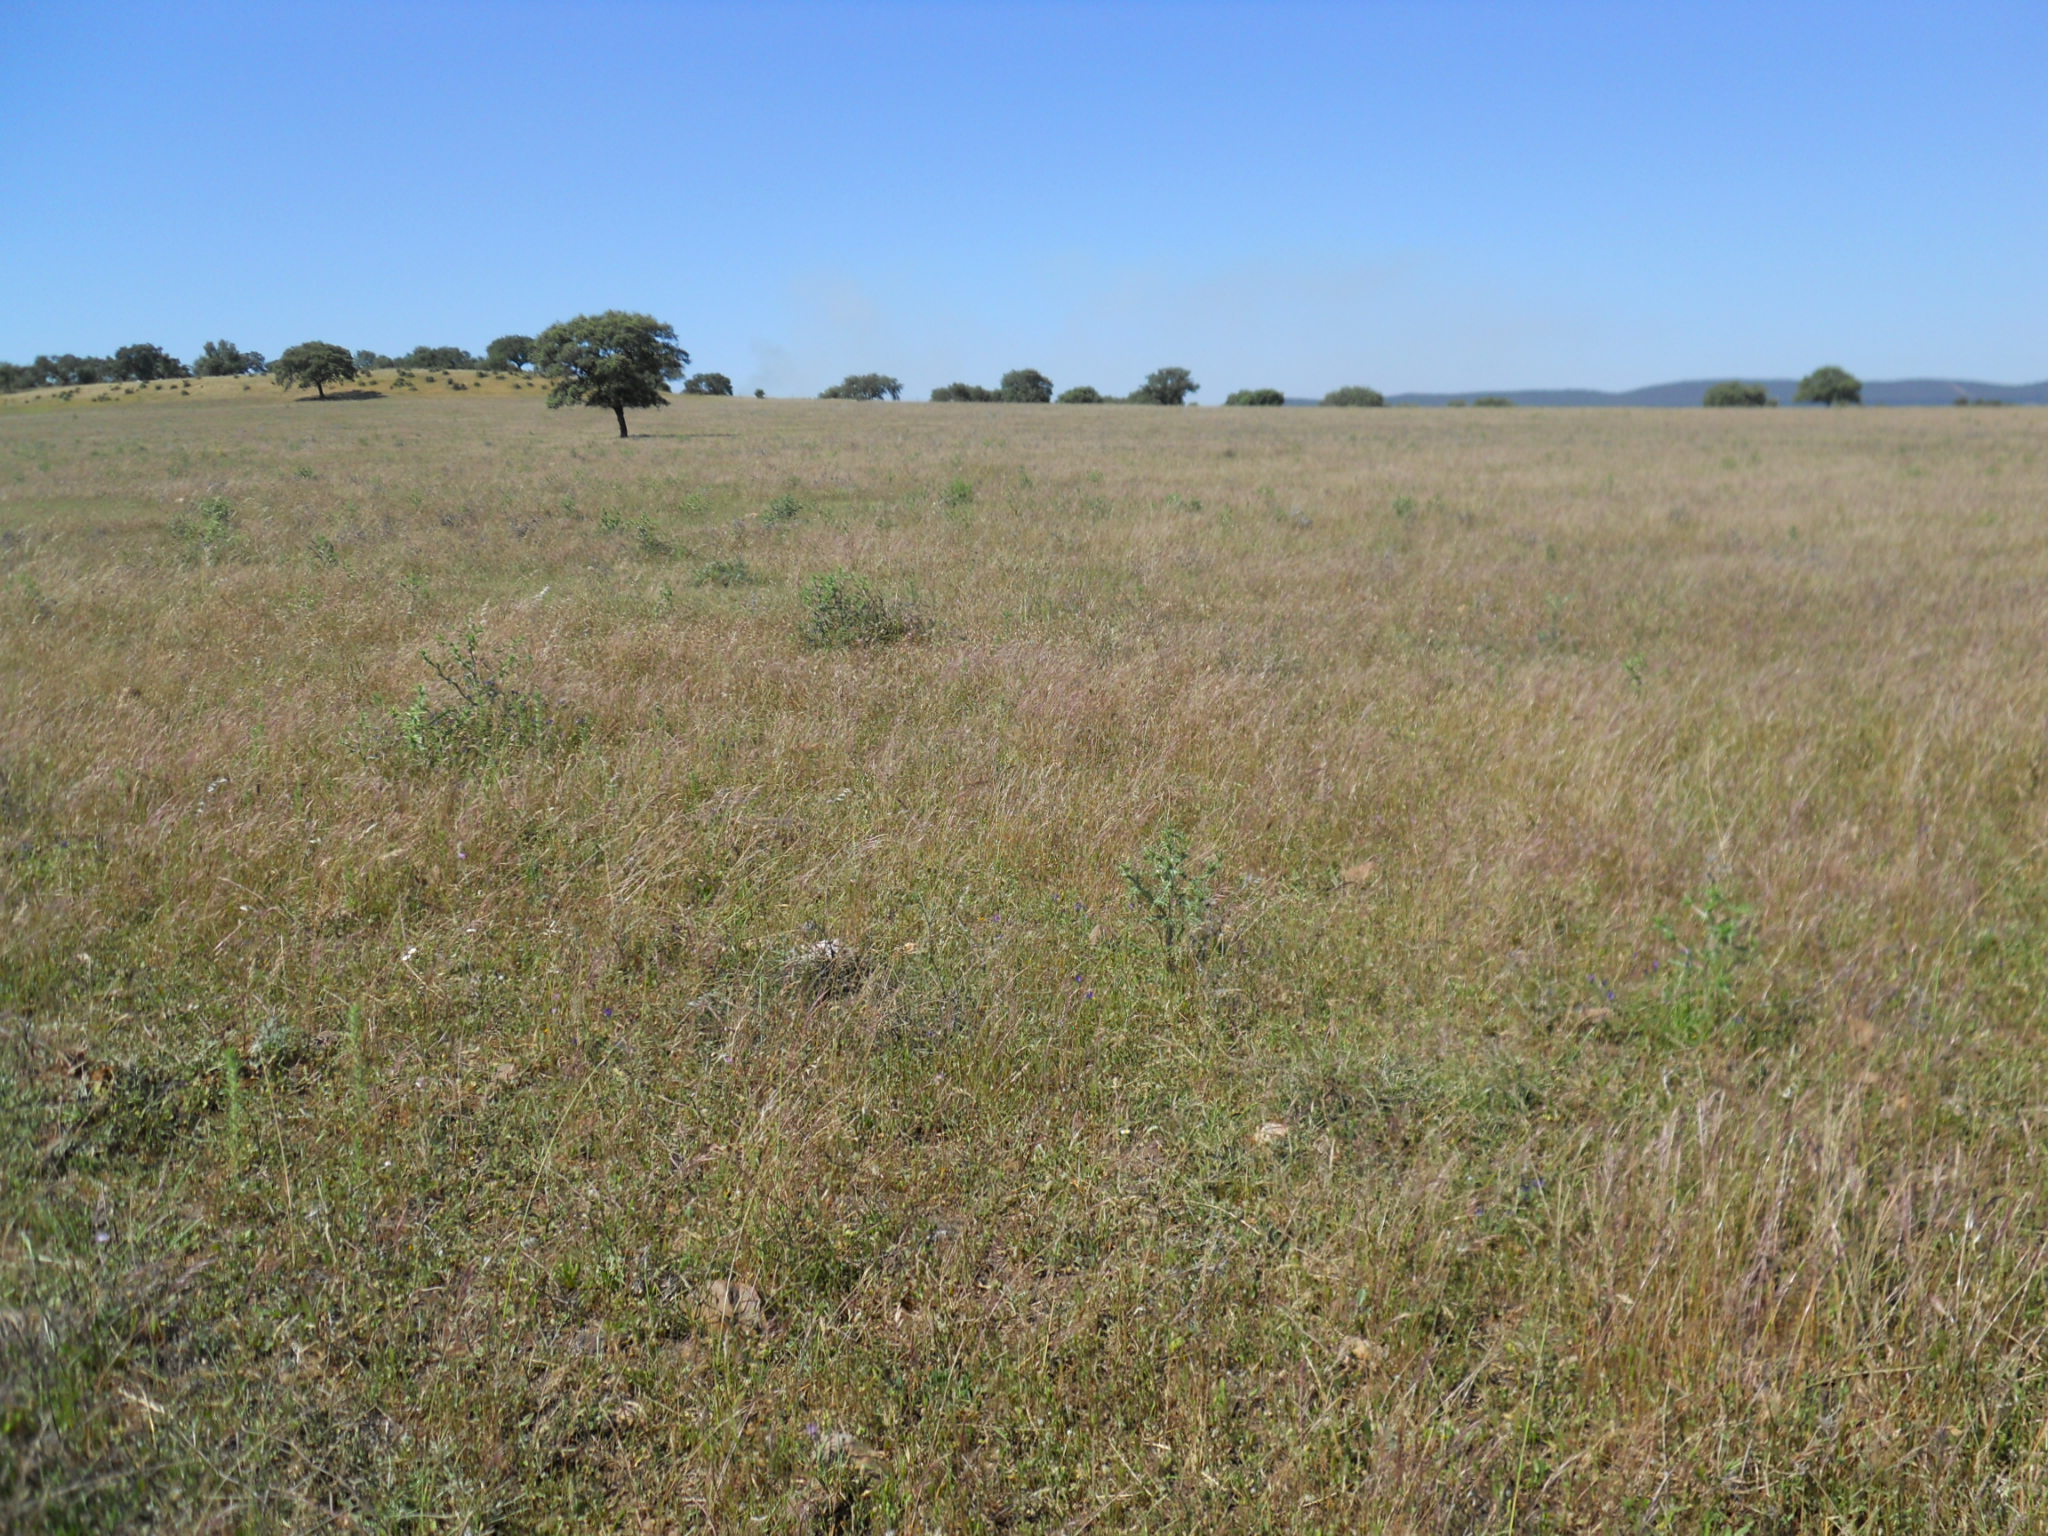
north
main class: Grassland
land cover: Grassland without tree/shrub cover
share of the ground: > 75 %
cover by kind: herbaceous plants 100 %
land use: Agriculture (excluding fallow land and kitchen gardens)
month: May
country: ES
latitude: 39.0665
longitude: -6.5808
